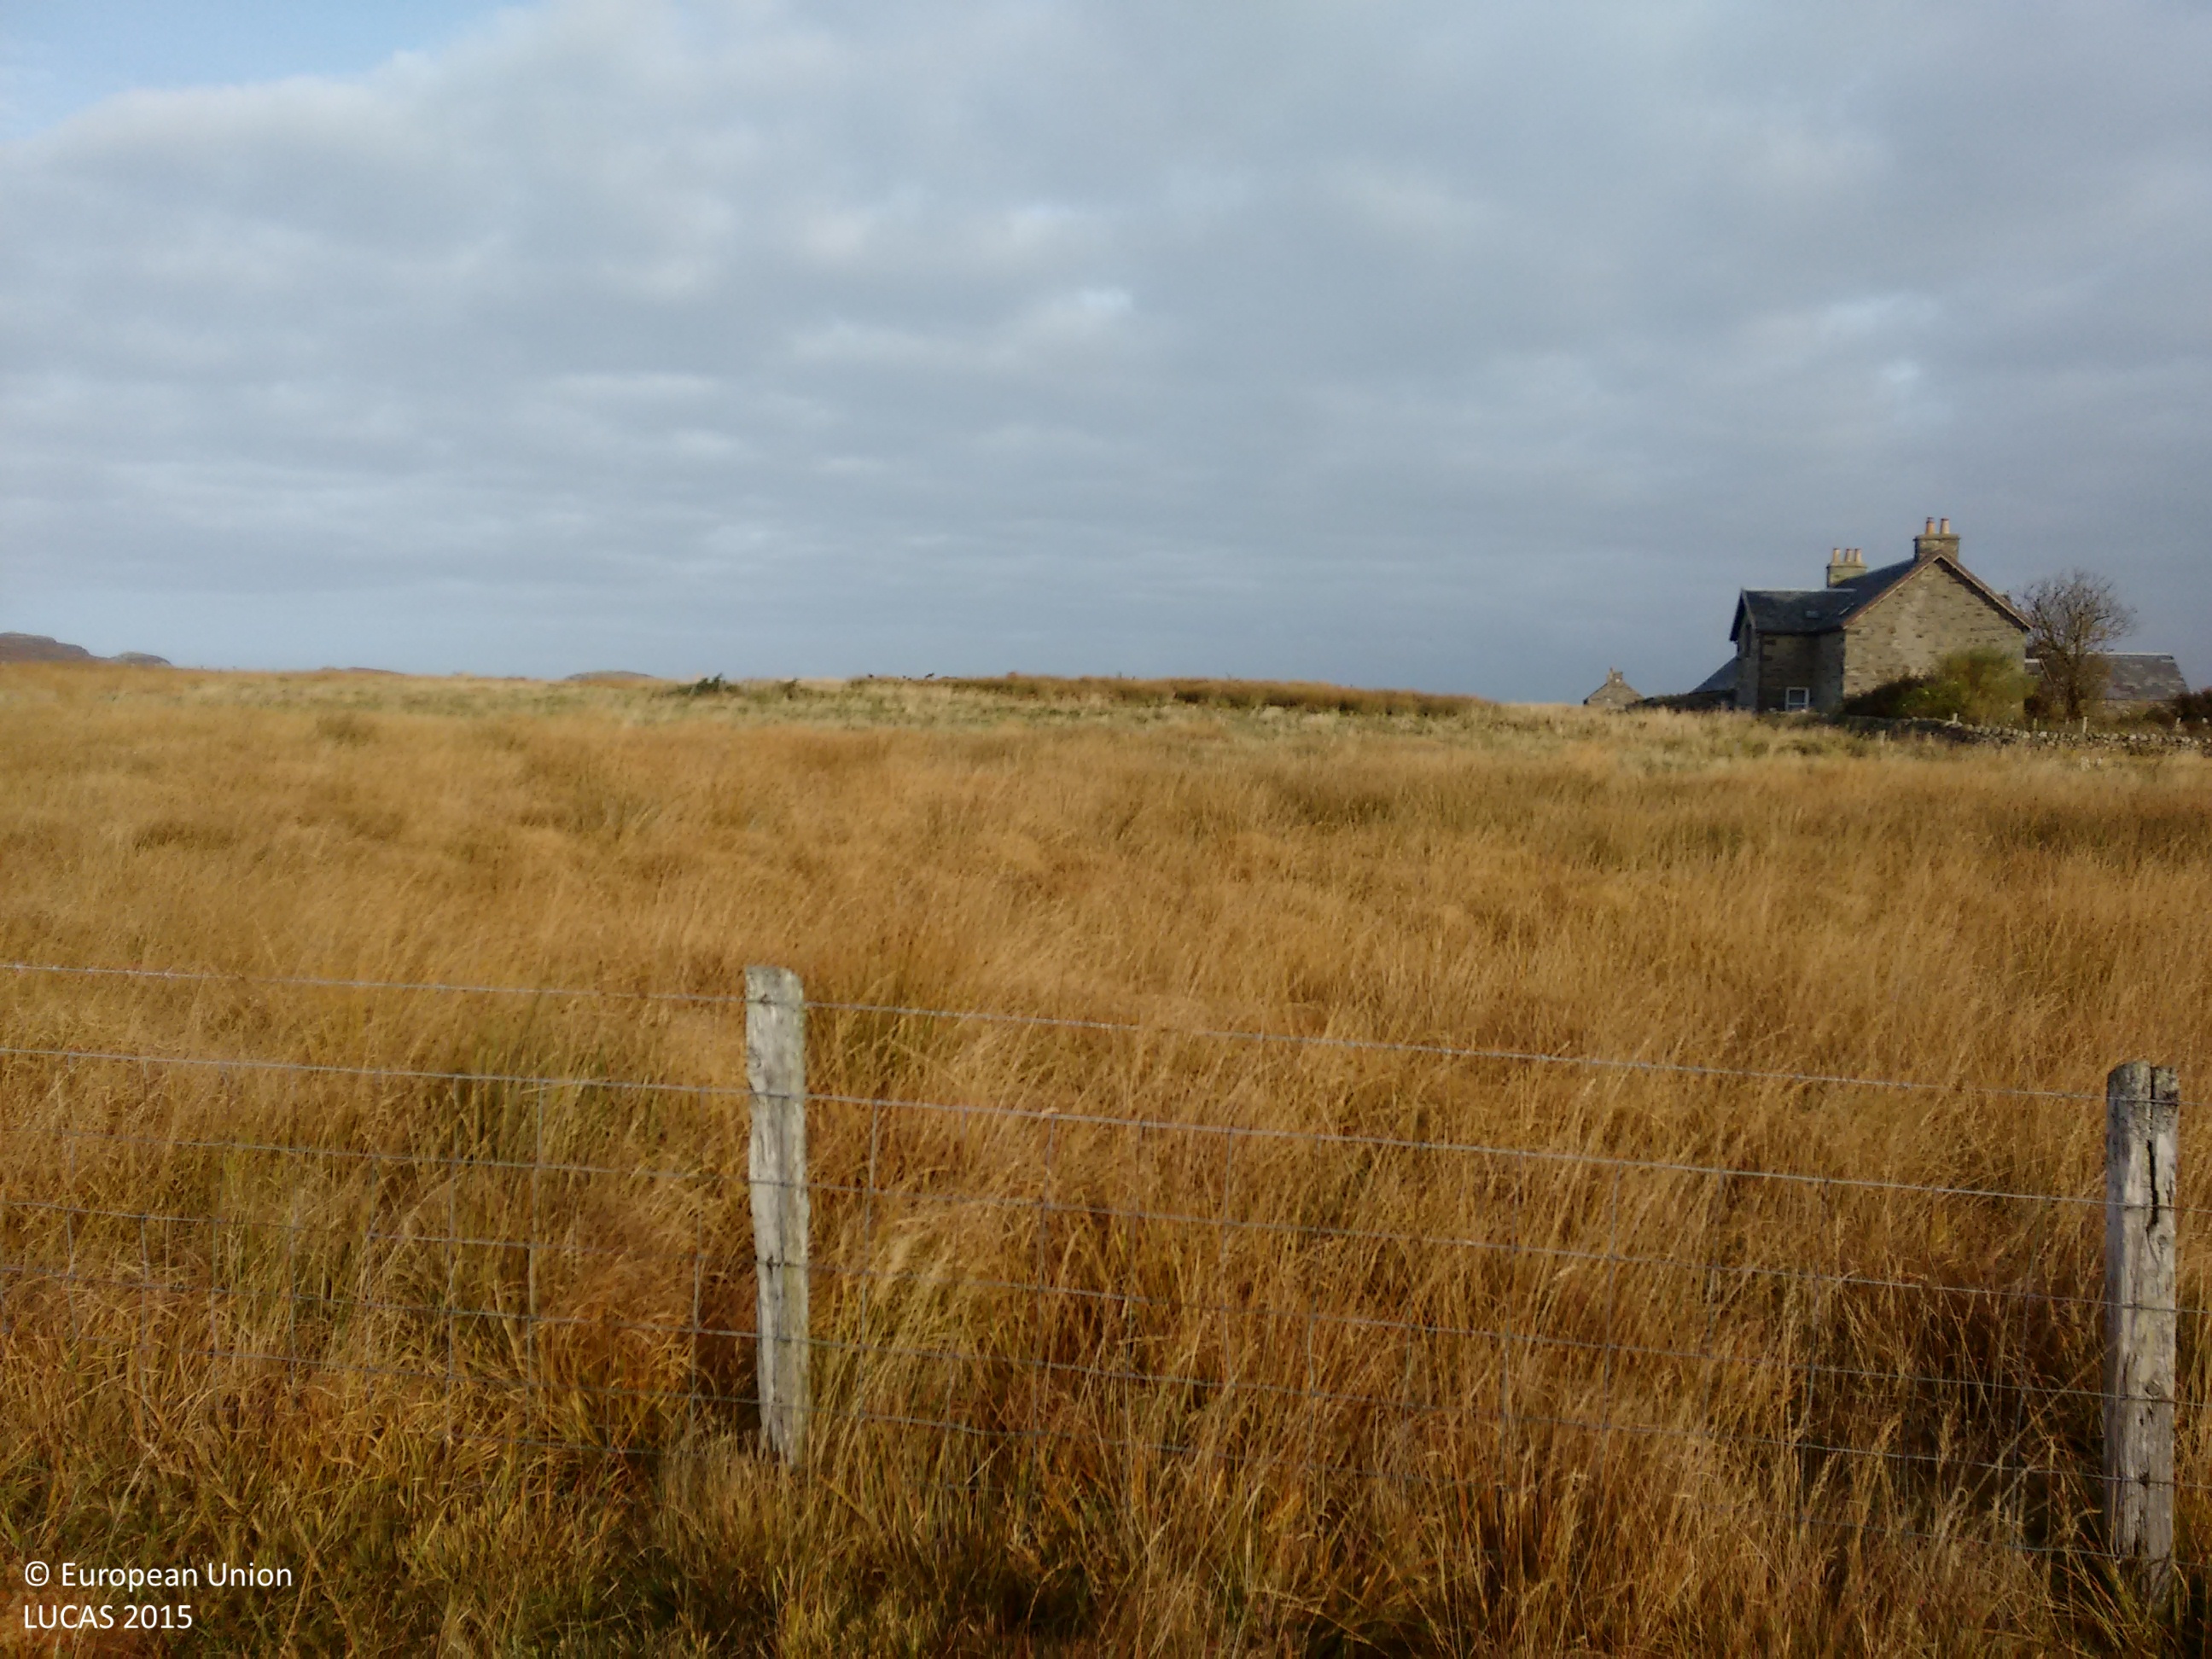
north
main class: Grassland
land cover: Grassland without tree/shrub cover
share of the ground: > 75 %
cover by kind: herbaceous plants 85 %, lichens and mosses 10 %, shrubs 5 %
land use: Agriculture (excluding fallow land and kitchen gardens)
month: October
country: GB
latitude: 55.8365
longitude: -6.4192
